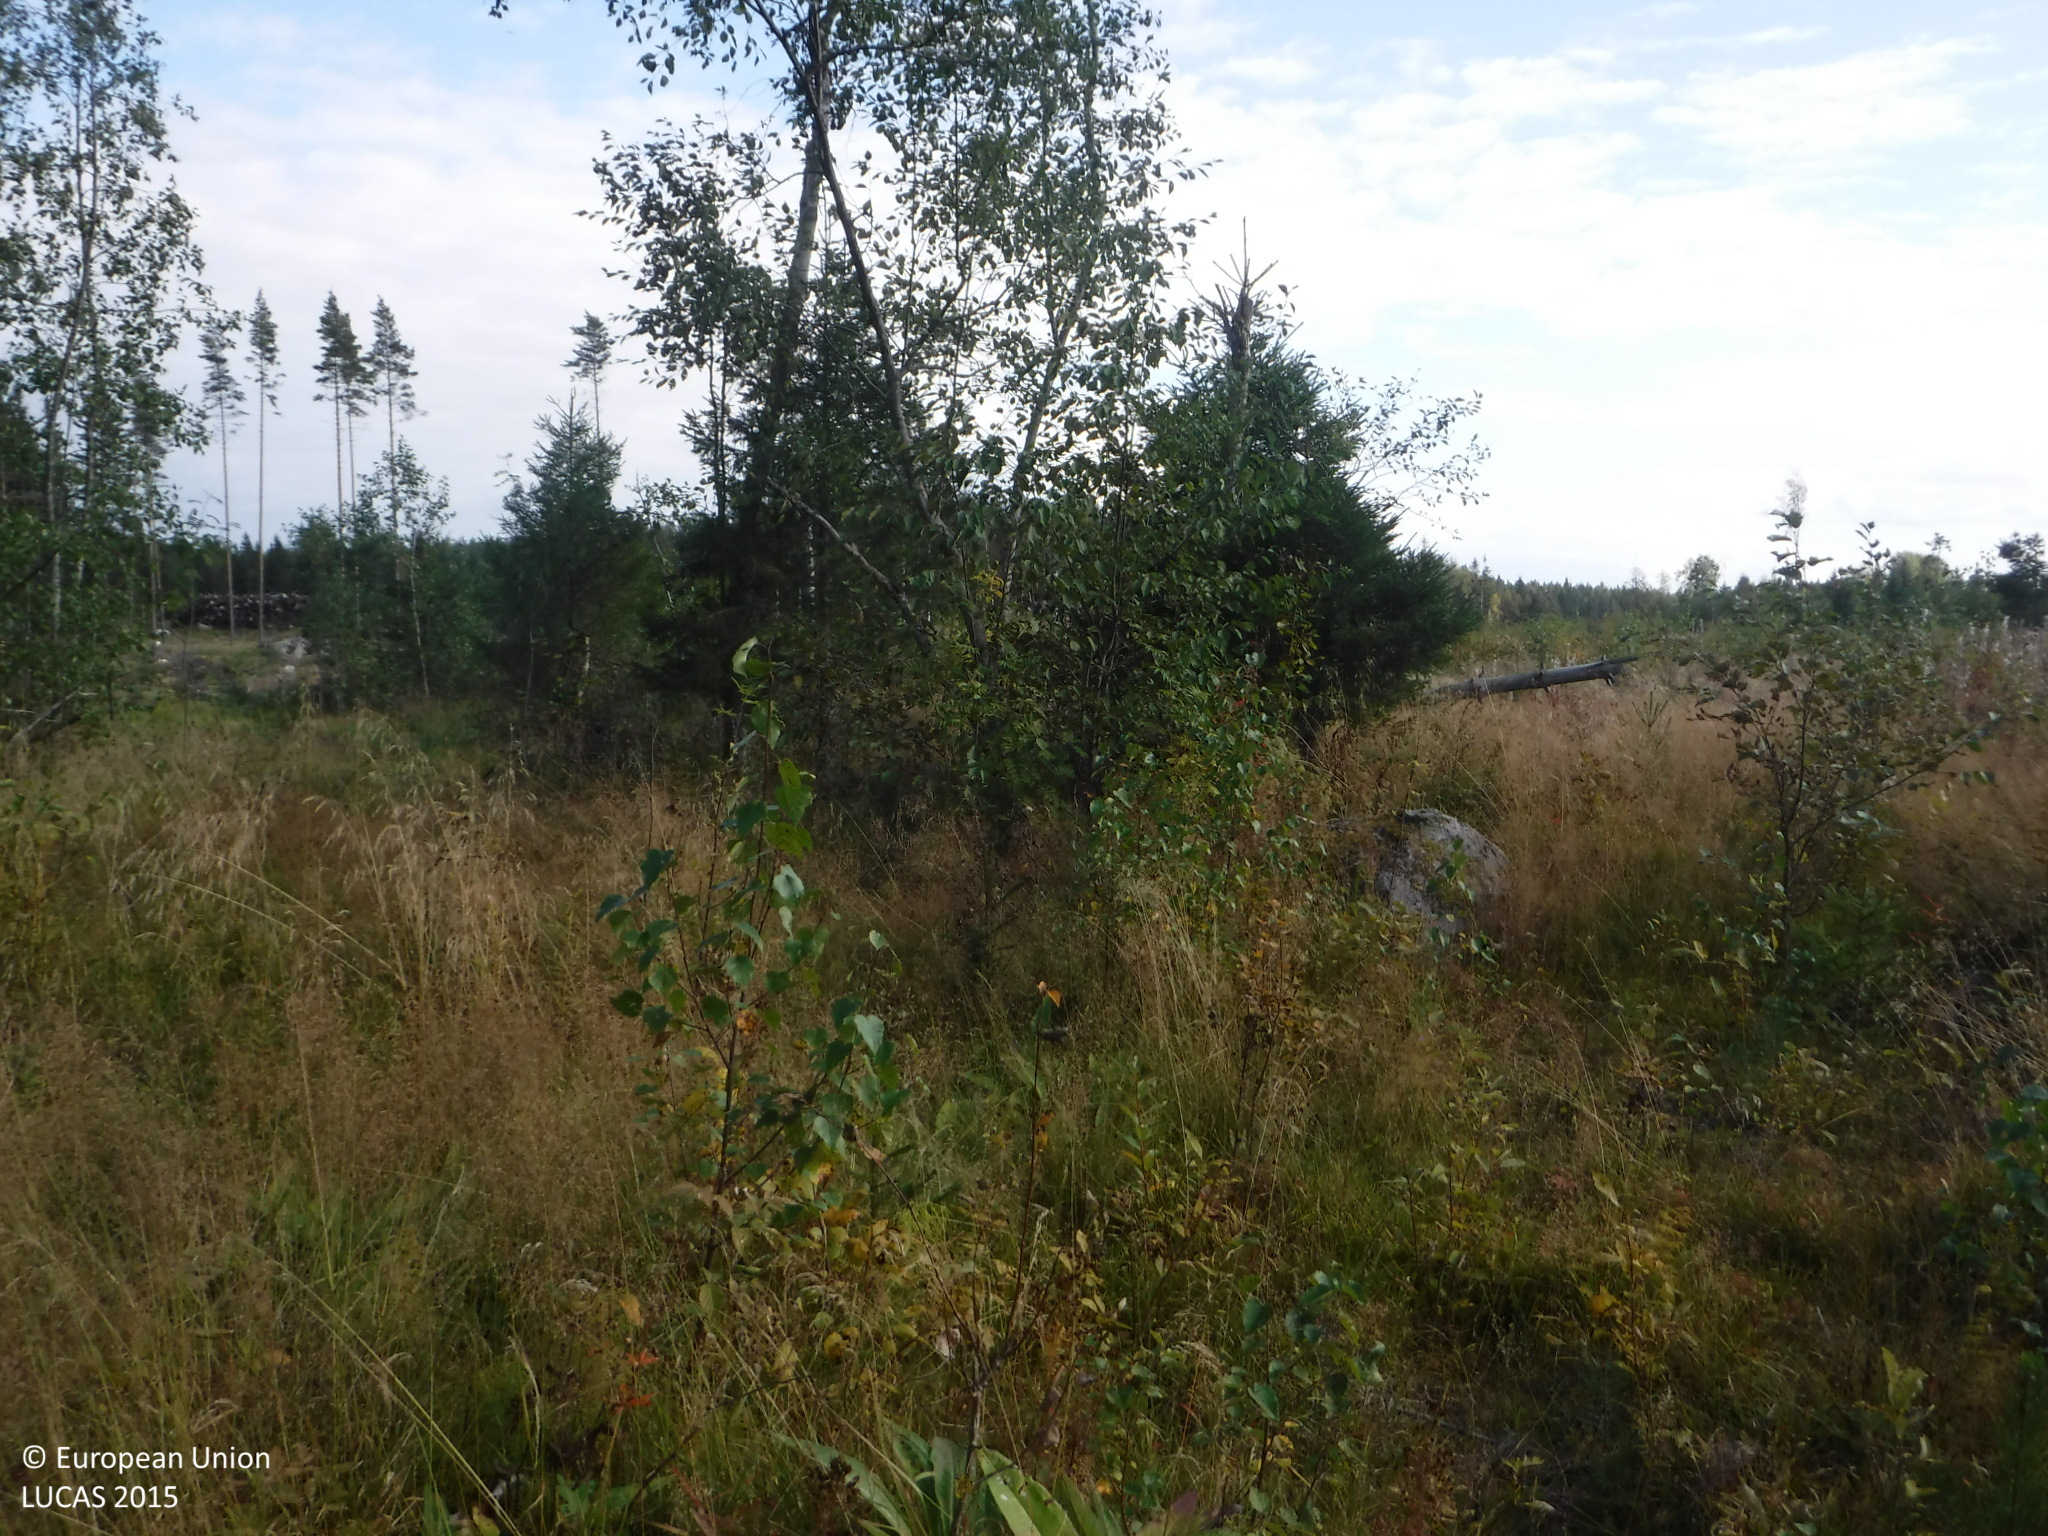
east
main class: Grassland
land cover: Grassland with sparse tree/shrub cover
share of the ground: > 75 %
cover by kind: herbaceous plants 95 %, broadleaved forest trees 5 %
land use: Forestry
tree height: < 5 m
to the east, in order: Grassland with sparse tree/shrub cover; Broadleaved woodland; Spontaneously vegetated surfaces; Other bare soil; Grass margins; Paved roads, cycling and walking lanes; Grassland with sparse tree/shrub cover
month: September
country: FI
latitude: 61.6666
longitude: 22.0880
